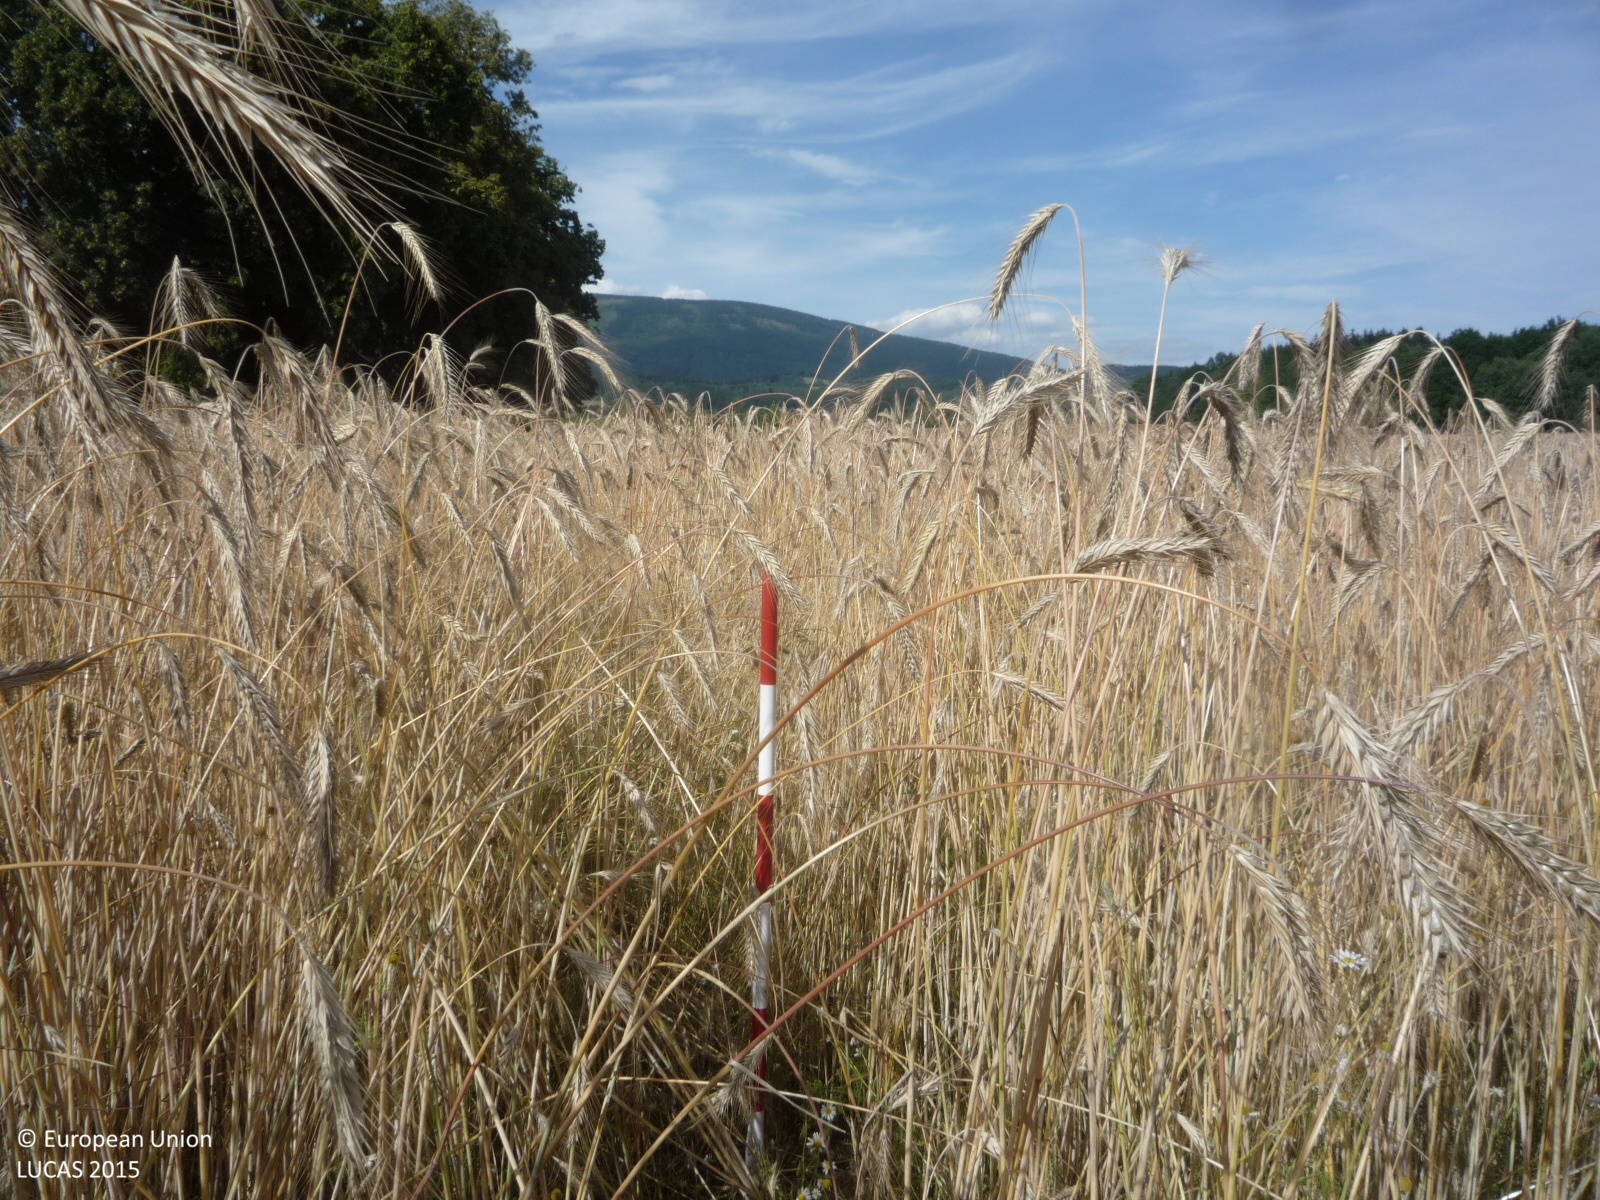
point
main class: Cropland
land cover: Rye
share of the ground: > 75 %
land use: Agriculture (excluding fallow land and kitchen gardens)
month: July
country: CZ
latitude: 50.6006
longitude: 15.6985
